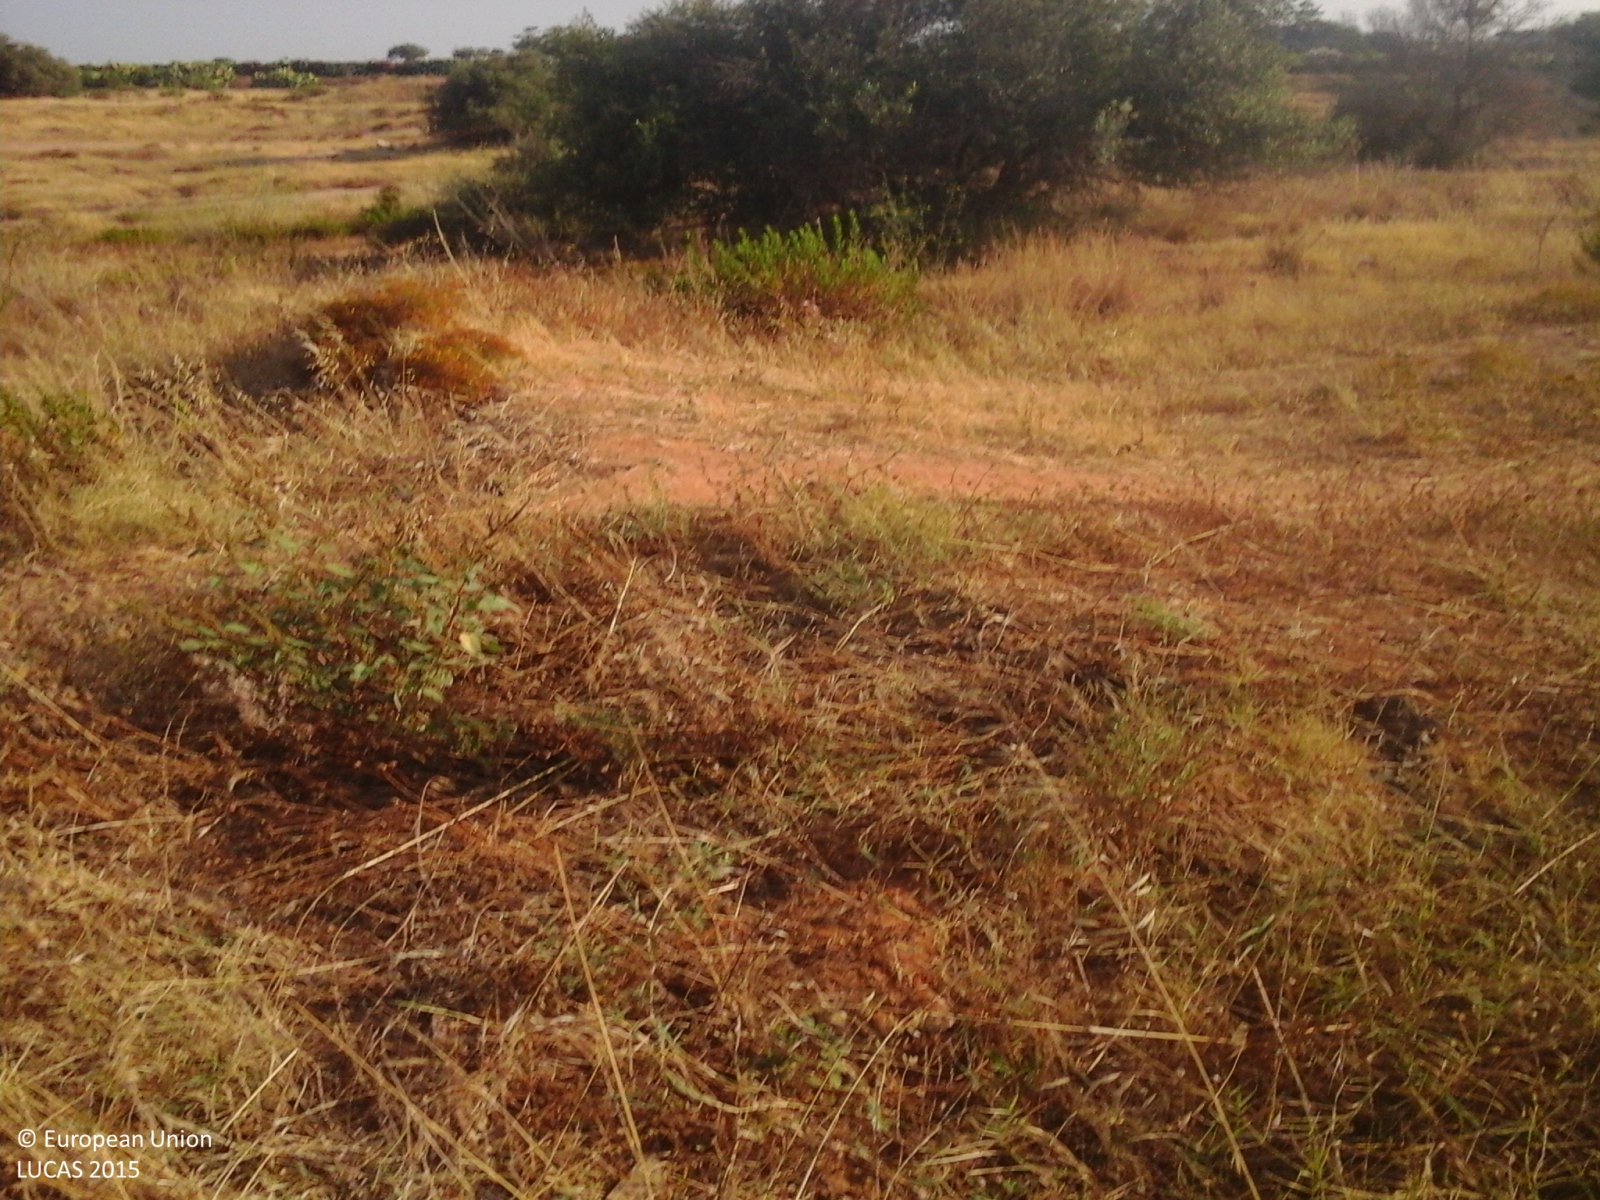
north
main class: Grassland
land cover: Grassland without tree/shrub cover
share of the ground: > 75 %
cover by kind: herbaceous plants 100 %
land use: Abandoned areas
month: July
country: IT
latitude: 36.9909
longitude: 14.4031
